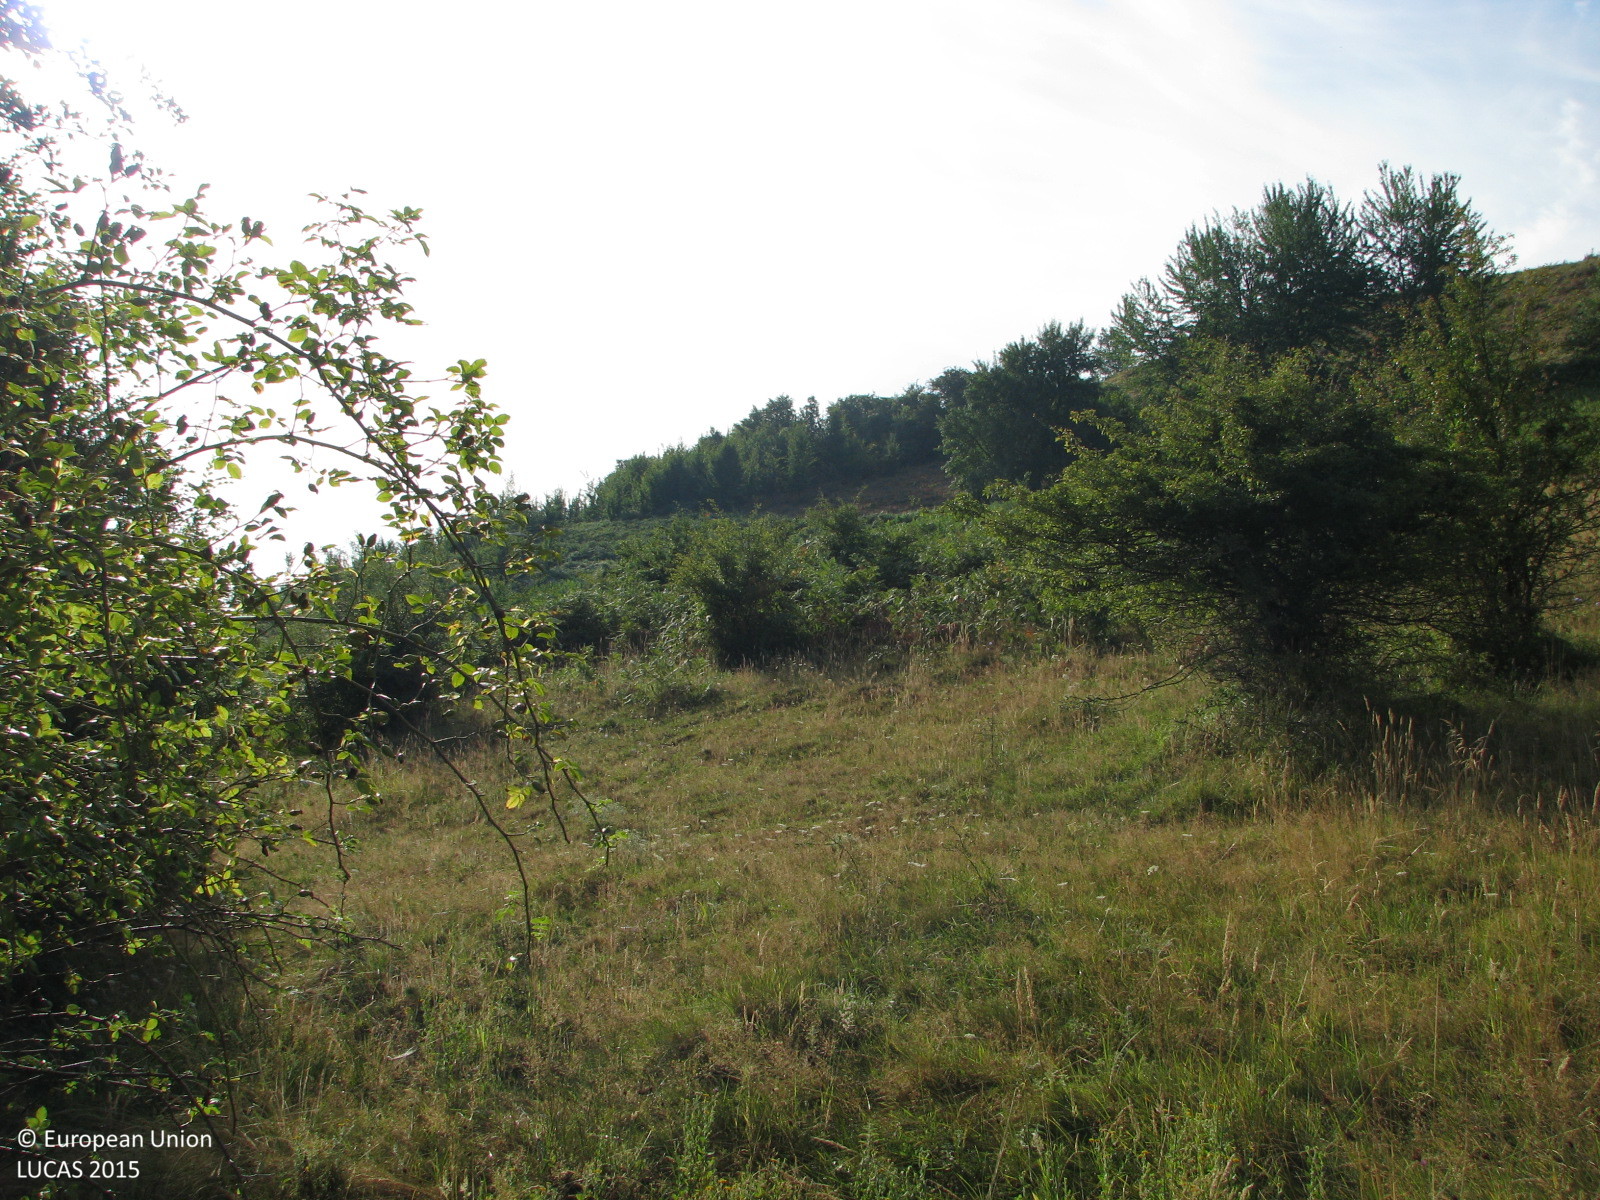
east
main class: Shrubland
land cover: Shrubland without tree cover
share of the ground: 25 - 50 %
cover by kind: herbaceous plants 55 %, shrubs 45 %
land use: Forestry
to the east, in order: Shrubland without tree cover; Broadleaved woodland; Shrubland without tree cover; Broadleaved woodland; Grassland with sparse tree/shrub cover; Broadleaved woodland
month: August
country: BG
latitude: 42.8851
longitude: 26.1907
